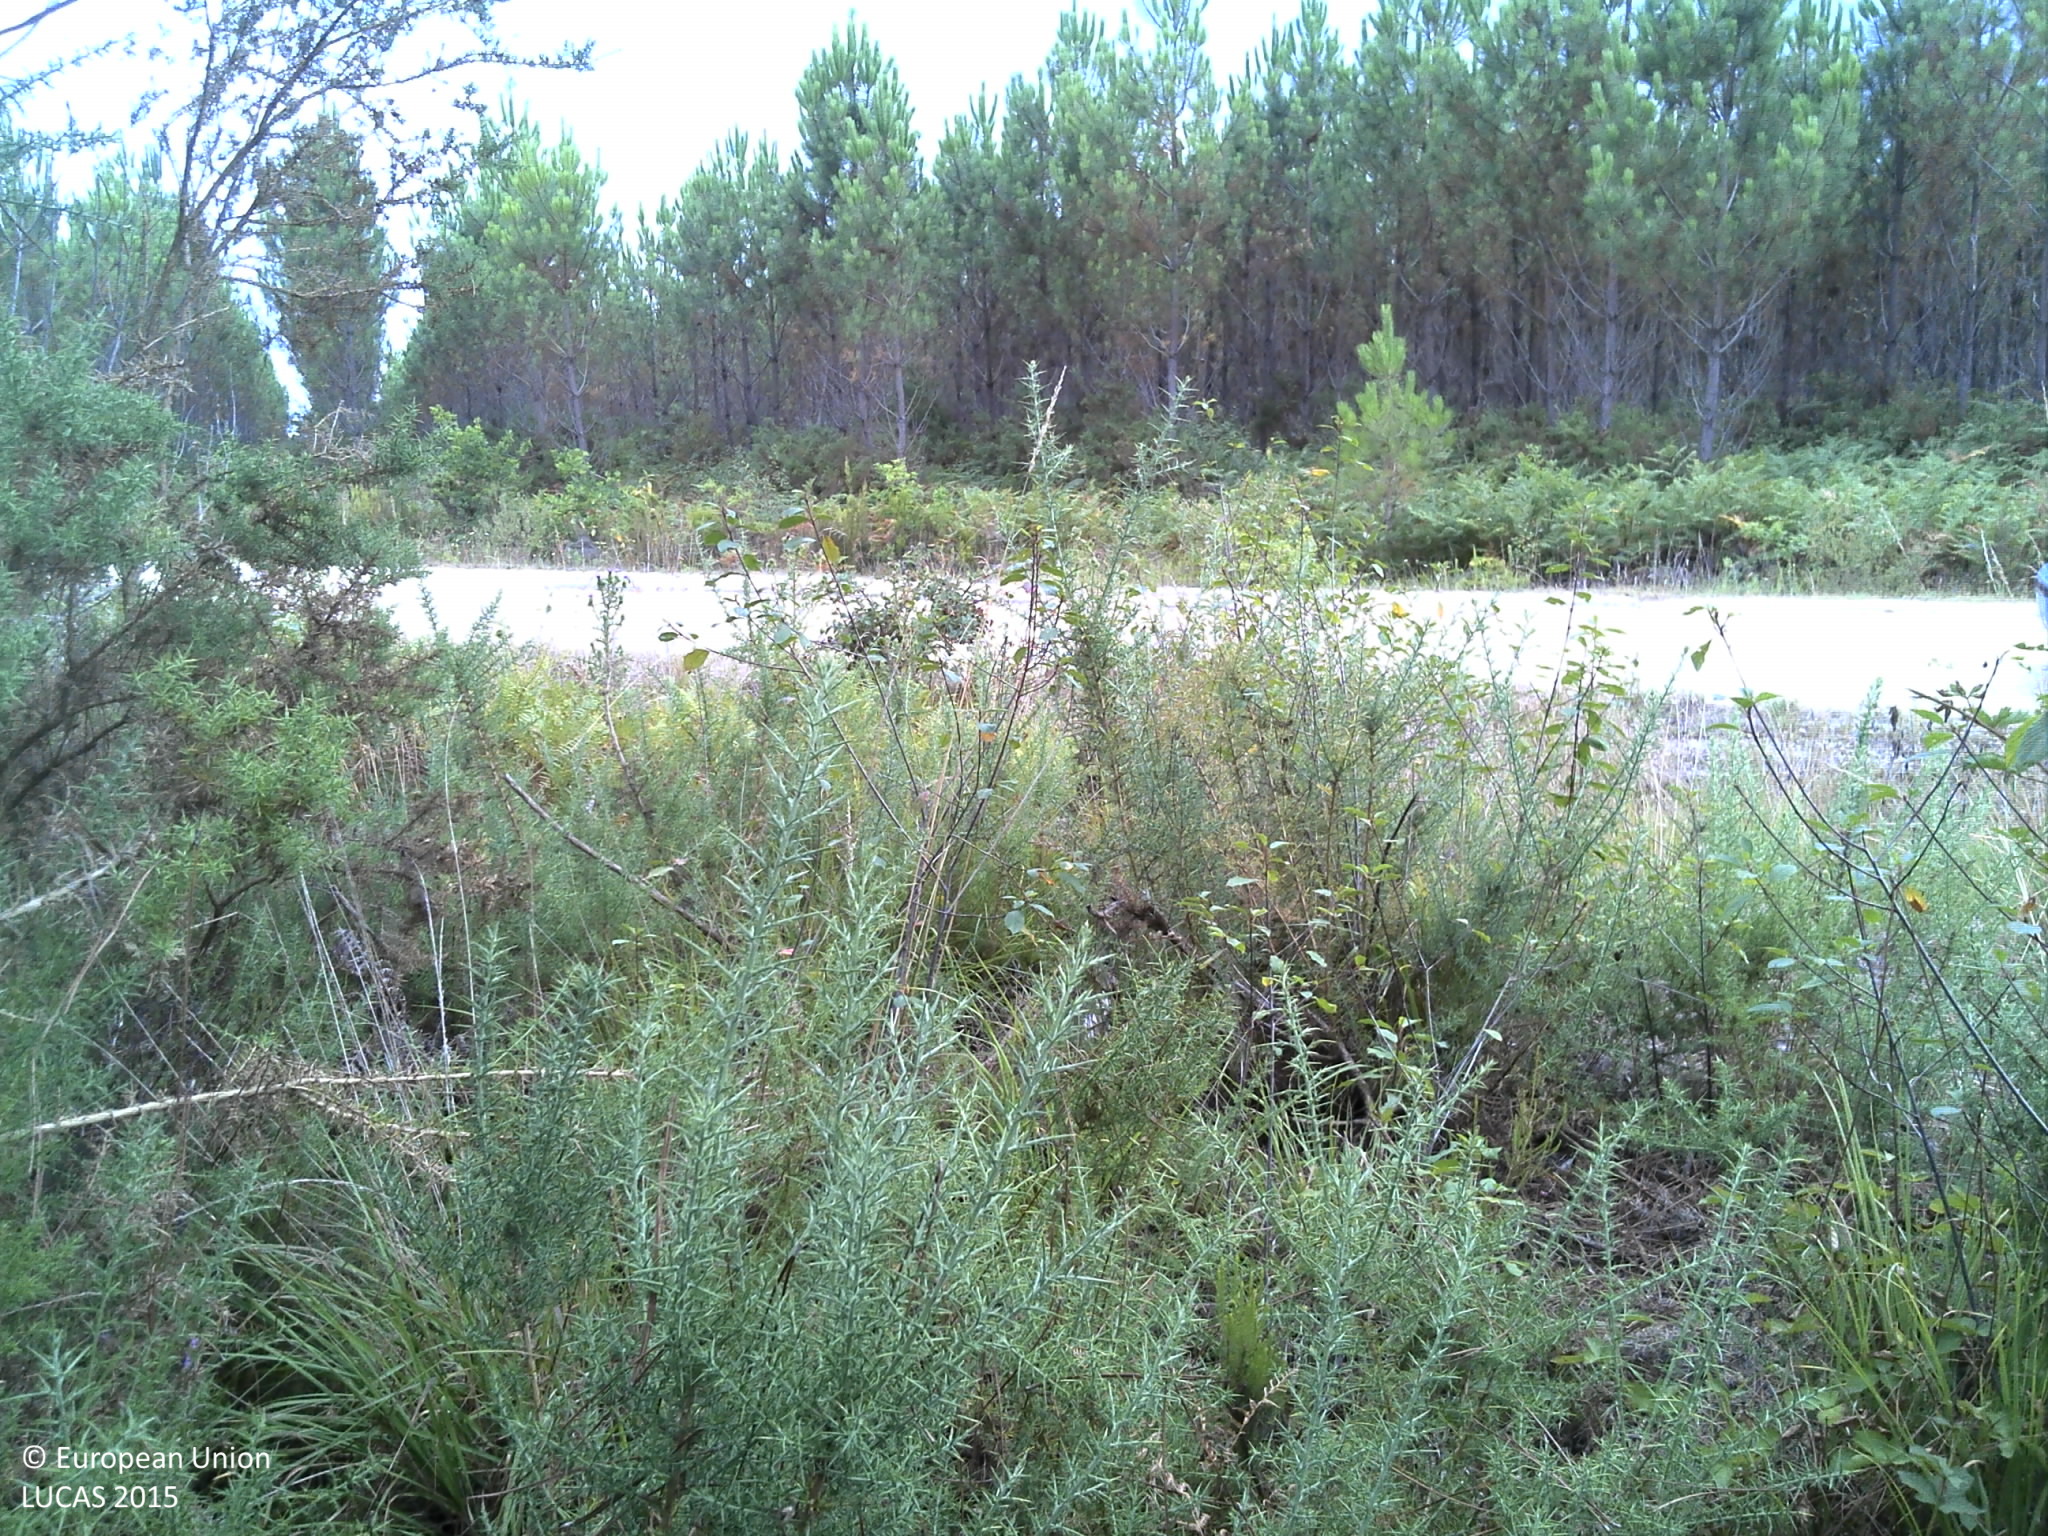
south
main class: Woodland
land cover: Pine dominated coniferous woodland
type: coniferous forest of the mediterranean region
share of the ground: > 75 %
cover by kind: coniferous forest trees 60 %, shrubs 30 %, herbaceous plants 5 %, lichens and mosses 5 %
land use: Forestry
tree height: > 5 m
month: August
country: FR
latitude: 44.6625
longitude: -0.9303
